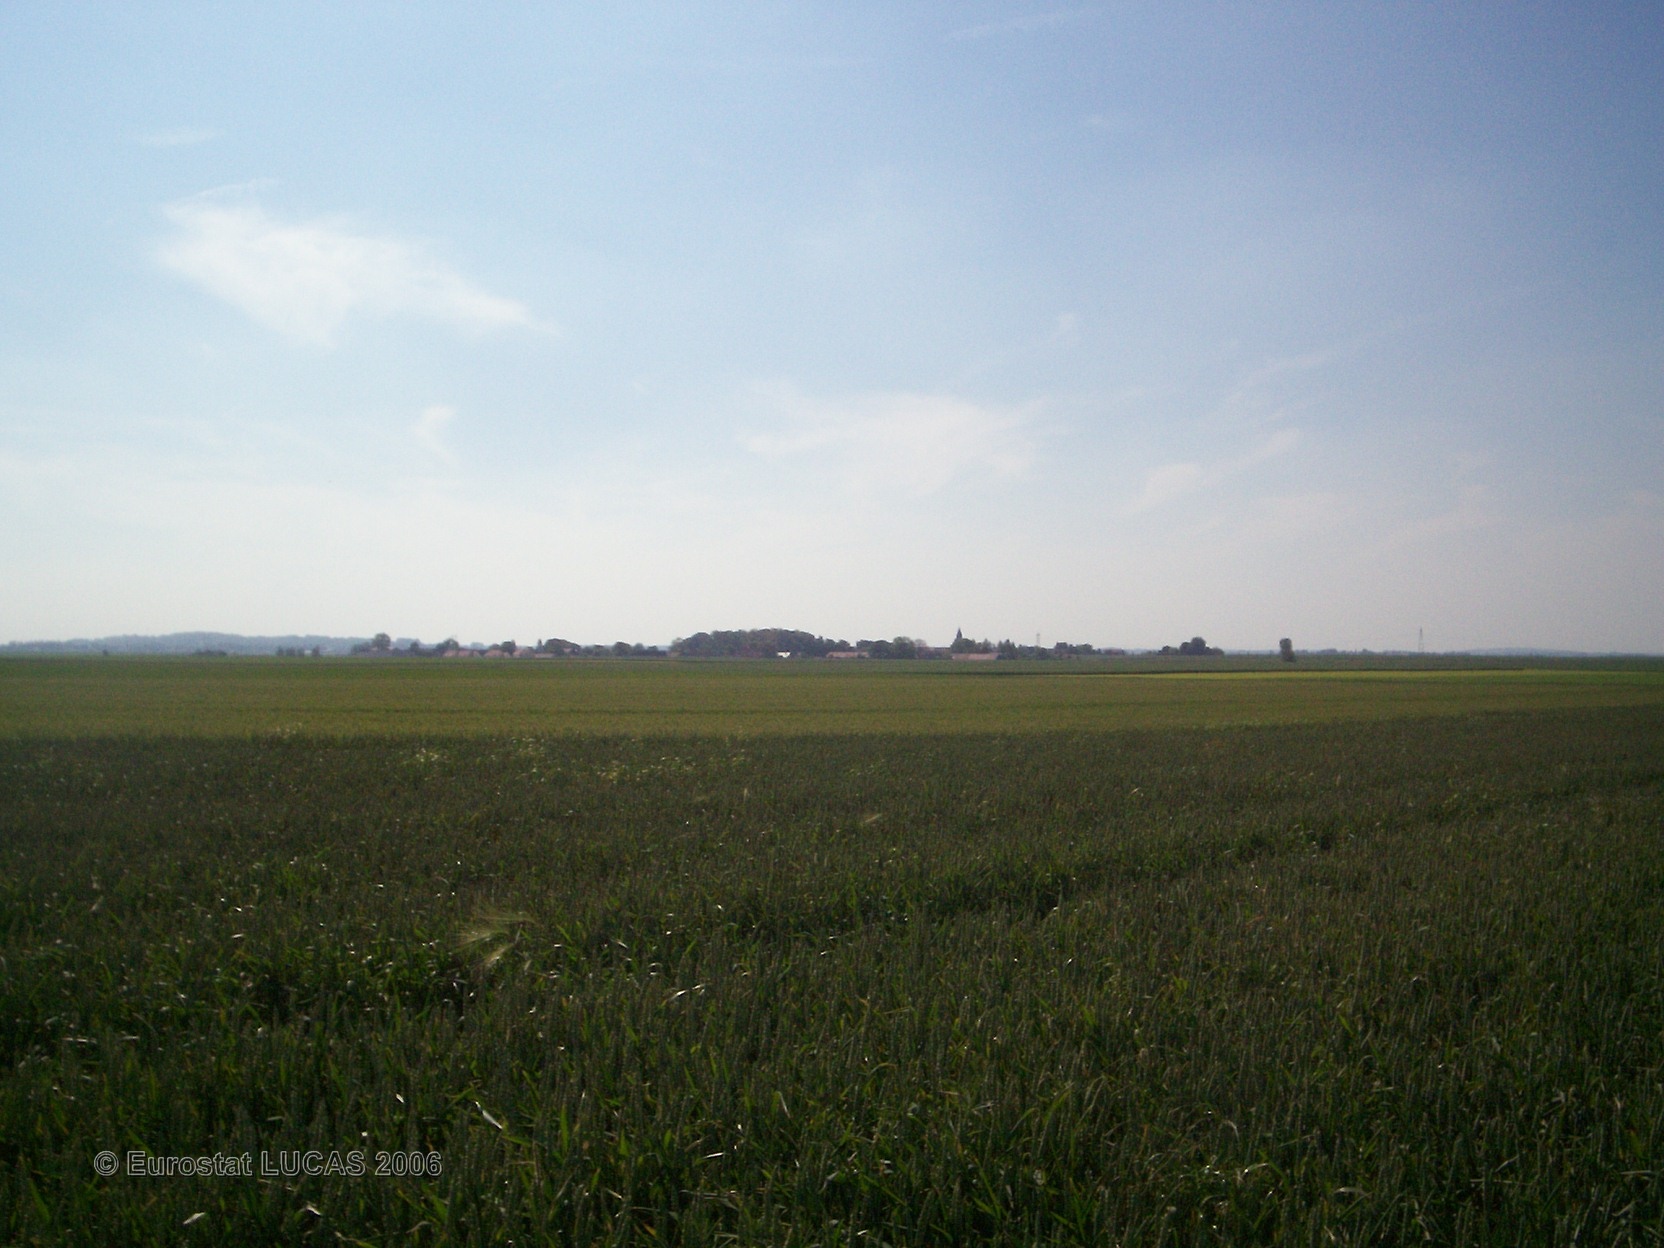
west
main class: Cropland
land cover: Common wheat
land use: Agriculture (excluding fallow land and kitchen gardens)
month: June
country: FR
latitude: 49.5674
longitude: 2.6466
